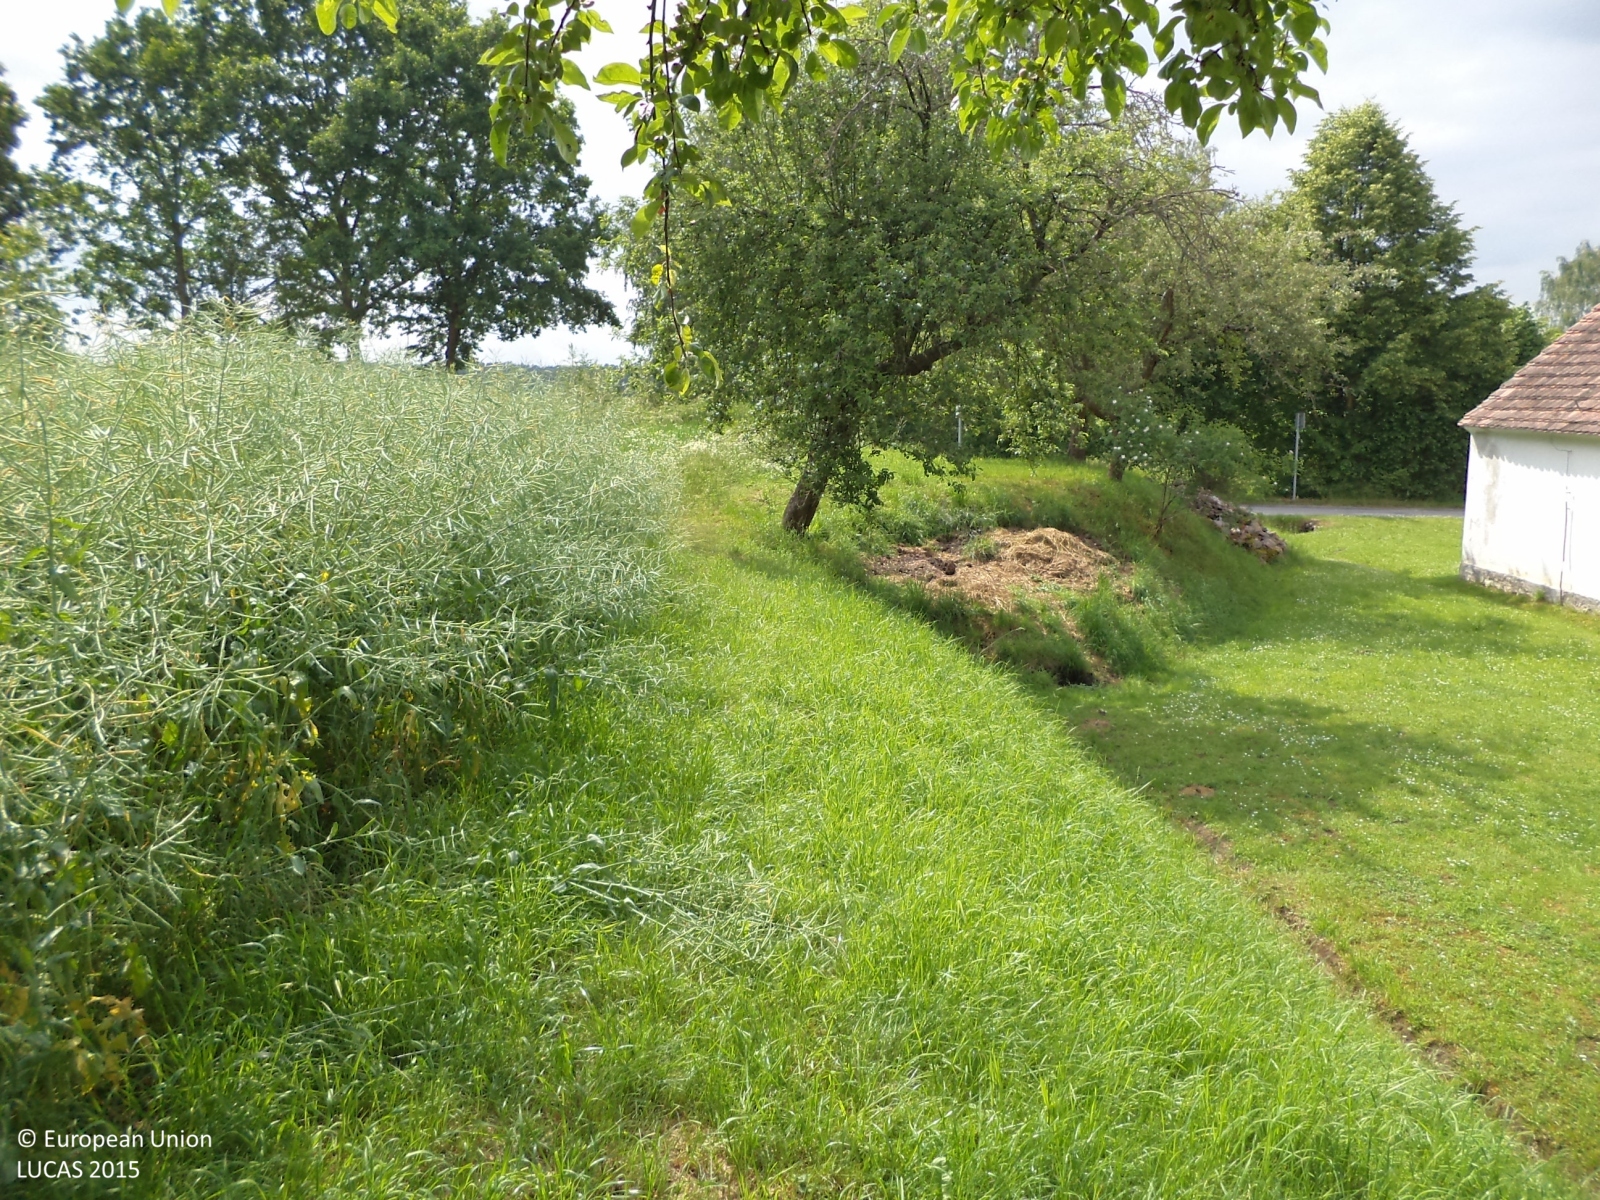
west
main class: Cropland
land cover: Apple fruit
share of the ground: 10 - 25 %
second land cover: Grassland without tree/shrub cover
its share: > 75 %
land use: Kitchen garden
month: June
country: CZ
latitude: 49.1931
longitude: 14.5434
